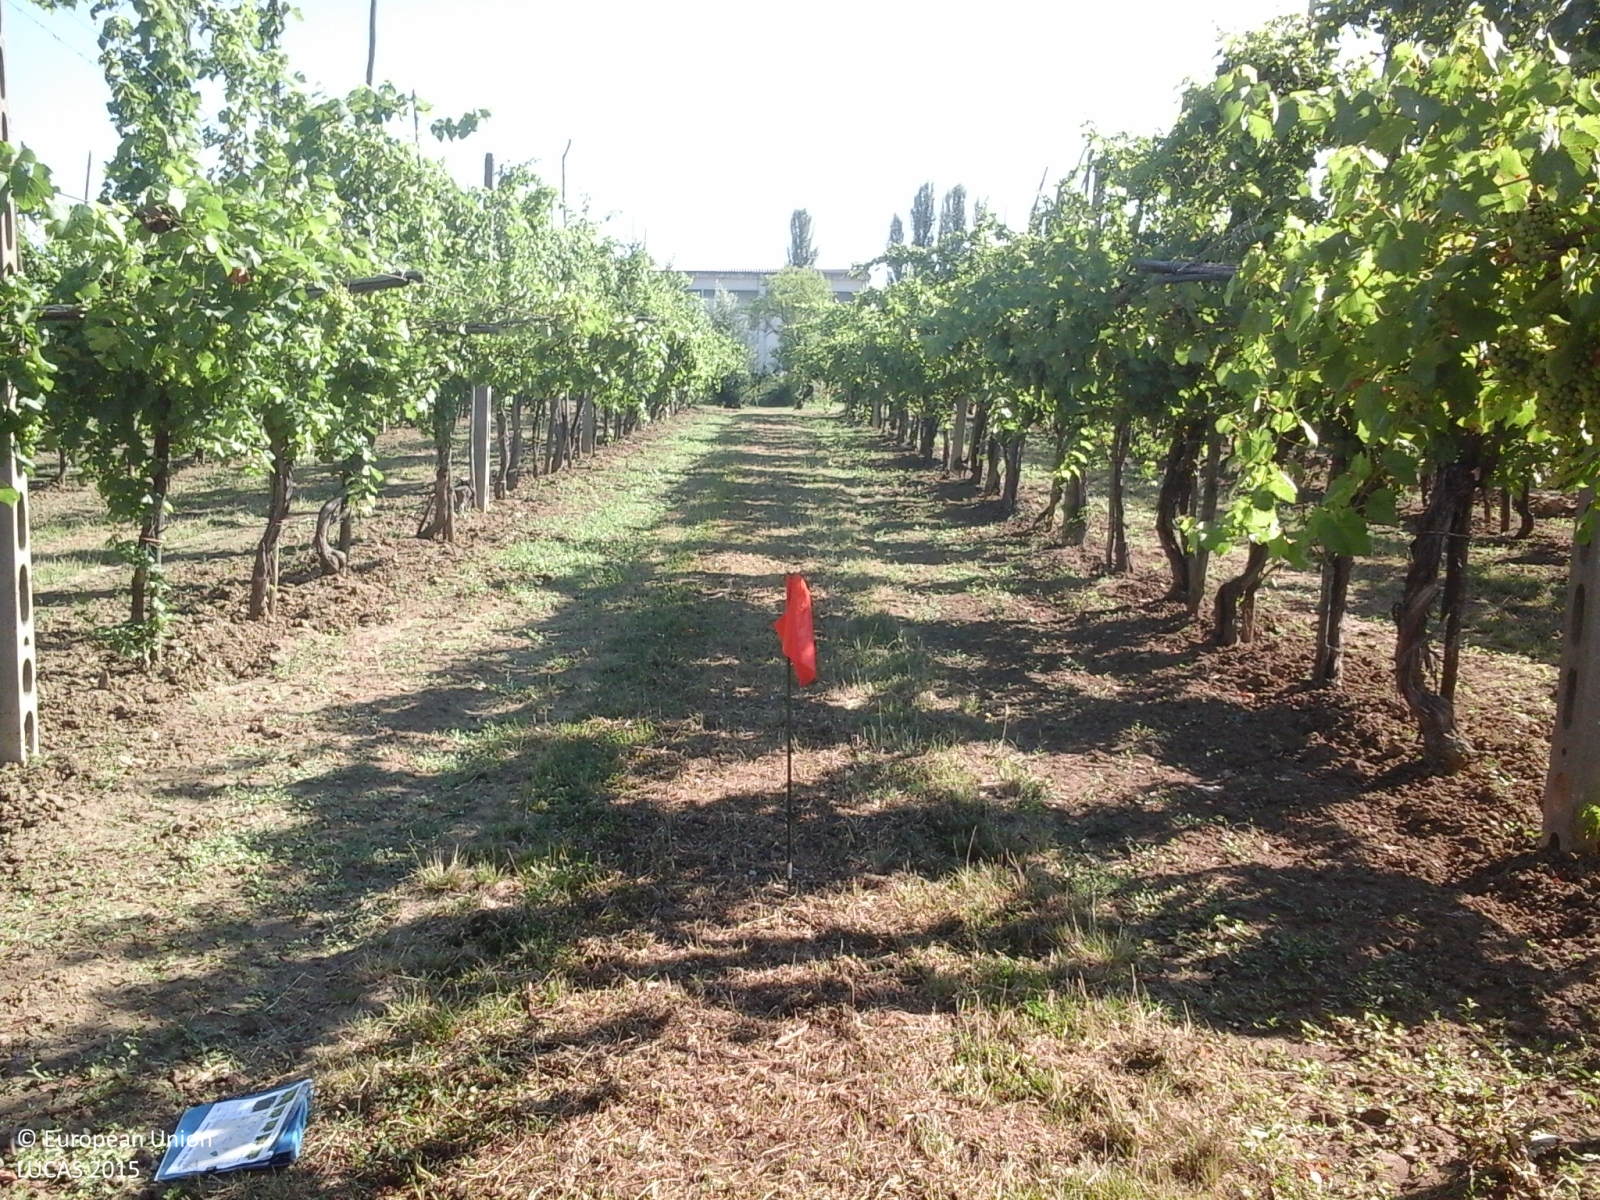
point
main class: Cropland
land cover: Vineyards
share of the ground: 25 - 50 %
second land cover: Grassland without tree/shrub cover
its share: > 75 %
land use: Agriculture (excluding fallow land and kitchen gardens)
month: July
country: IT
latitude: 44.4286
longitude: 11.5918
